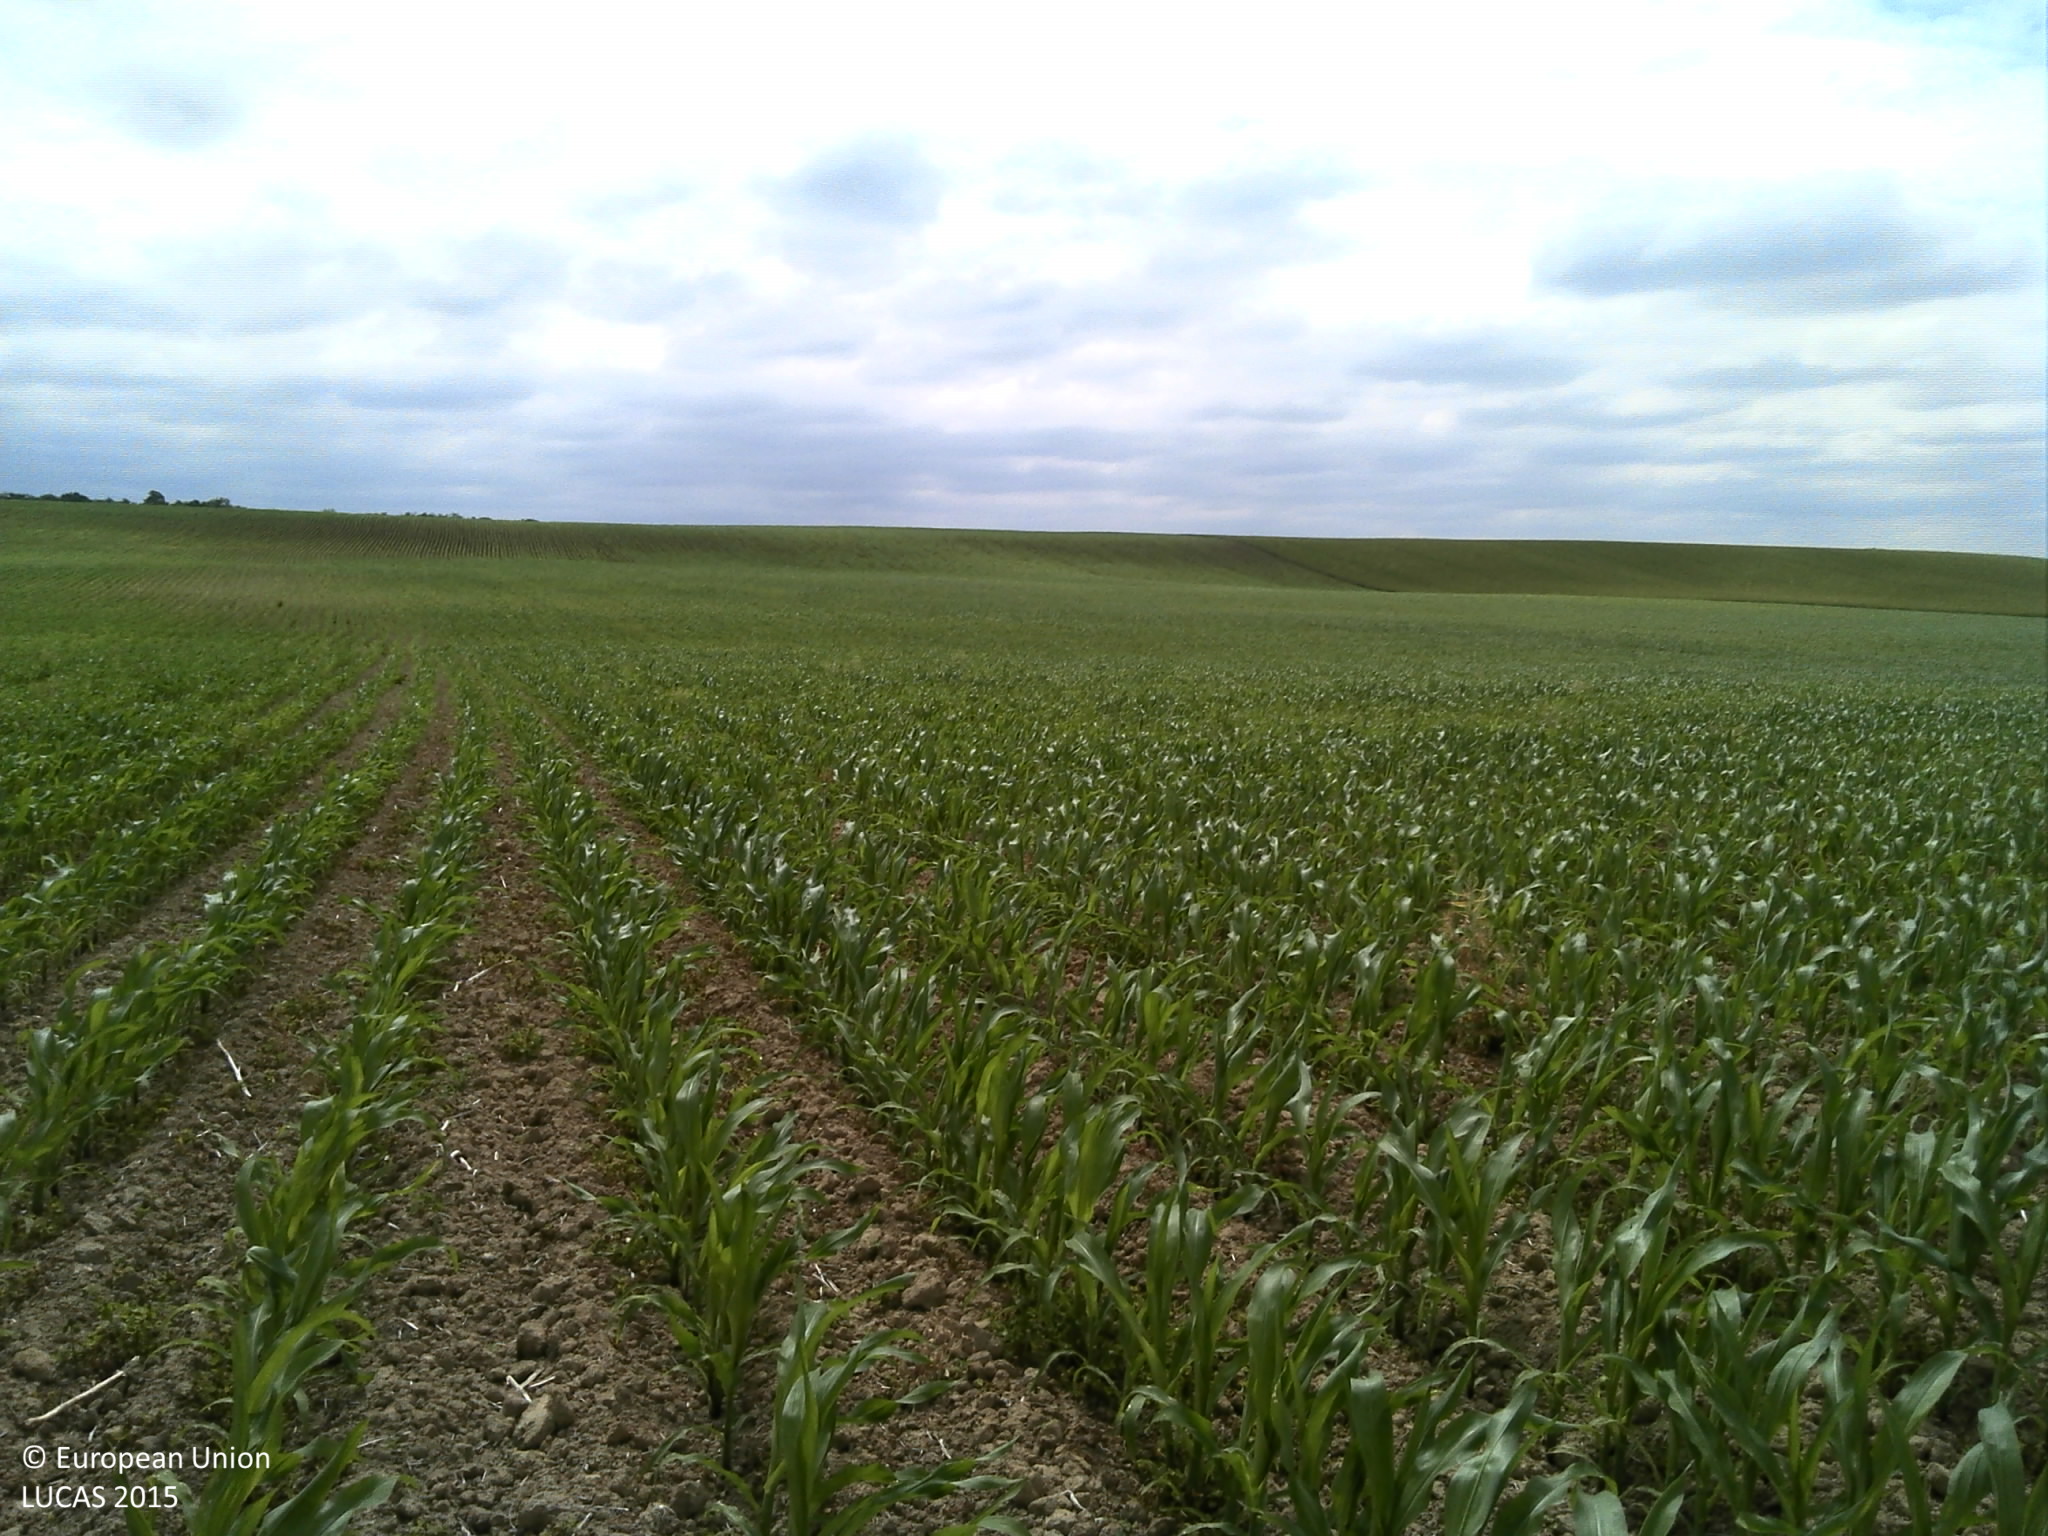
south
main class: Cropland
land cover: Maize
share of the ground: 50 - 75 %
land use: Agriculture (excluding fallow land and kitchen gardens)
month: June
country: FR
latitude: 48.8246
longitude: 6.7722
